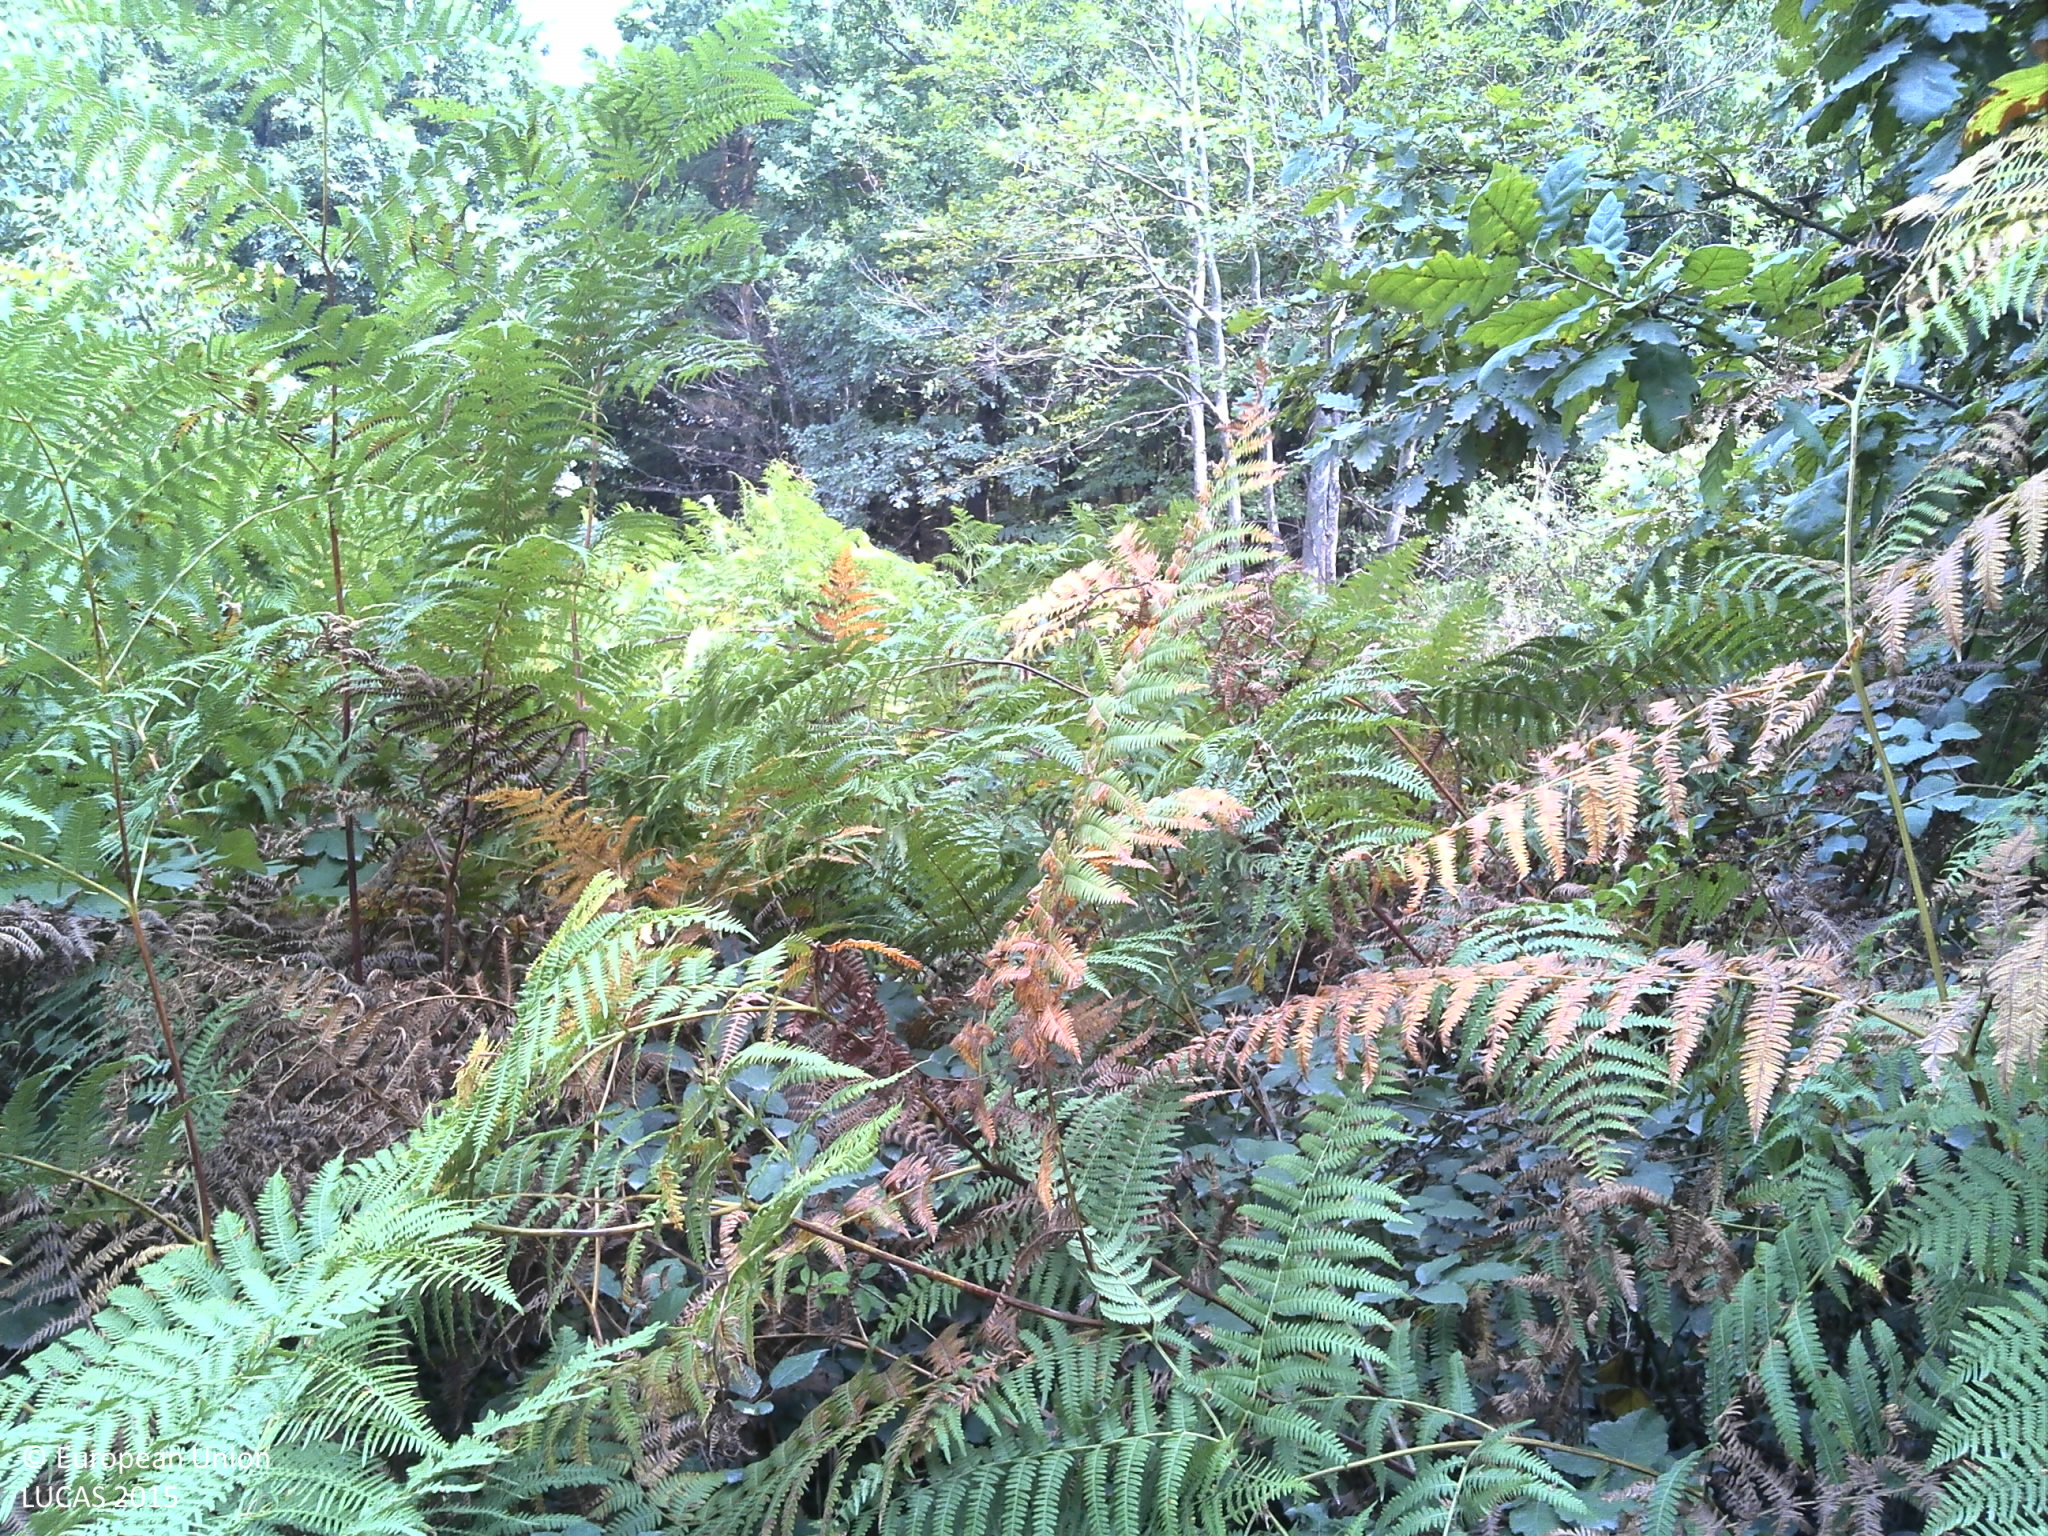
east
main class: Shrubland
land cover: Shrubland with sparse tree cover
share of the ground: > 75 %
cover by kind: shrubs 95 %, broadleaved forest trees 5 %
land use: Forestry
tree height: < 5 m
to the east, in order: Shrubland with sparse tree cover; Paved roads, cycling and walking lanes; Broadleaved woodland; Shrubland with sparse tree cover; Broadleaved woodland
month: August
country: HR
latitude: 45.2227
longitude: 16.0456
